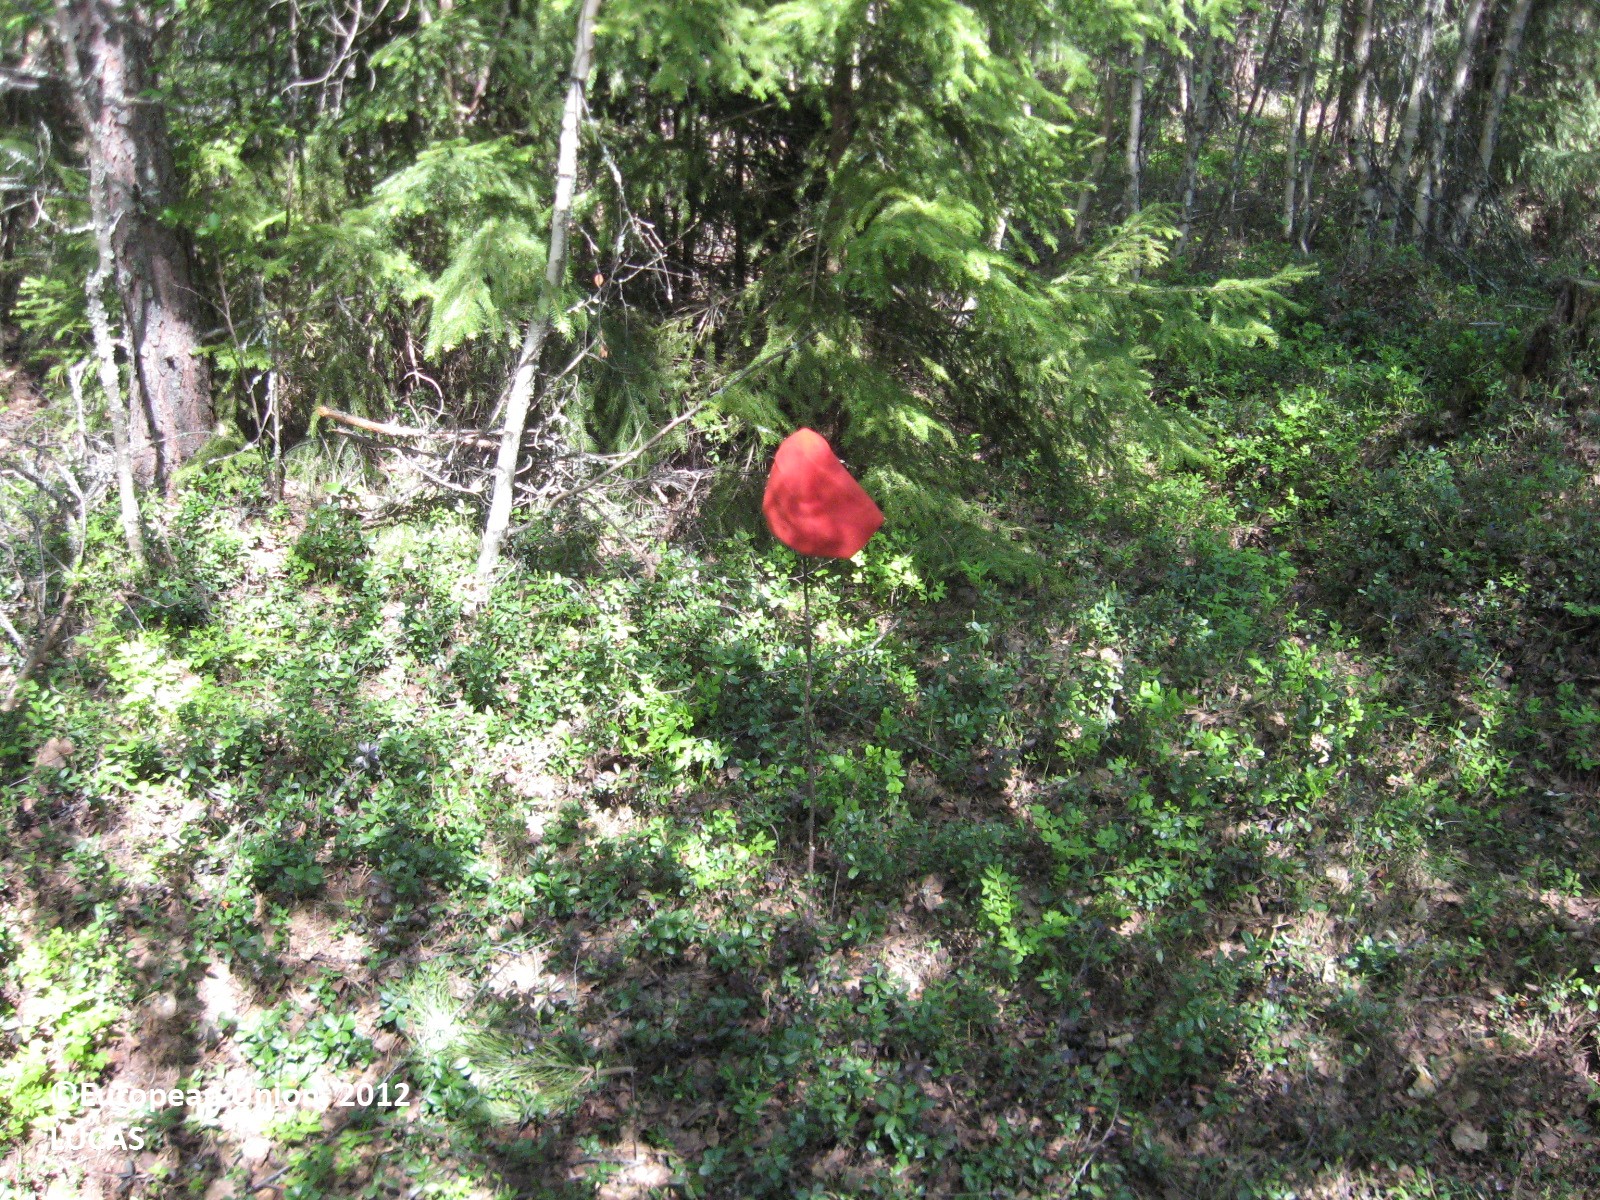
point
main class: Woodland
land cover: Pine dominated mixed woodland
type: boreal forest
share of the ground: > 75 %
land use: Forestry
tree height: > 5 m
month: June
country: FI
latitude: 63.2042
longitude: 21.3496
